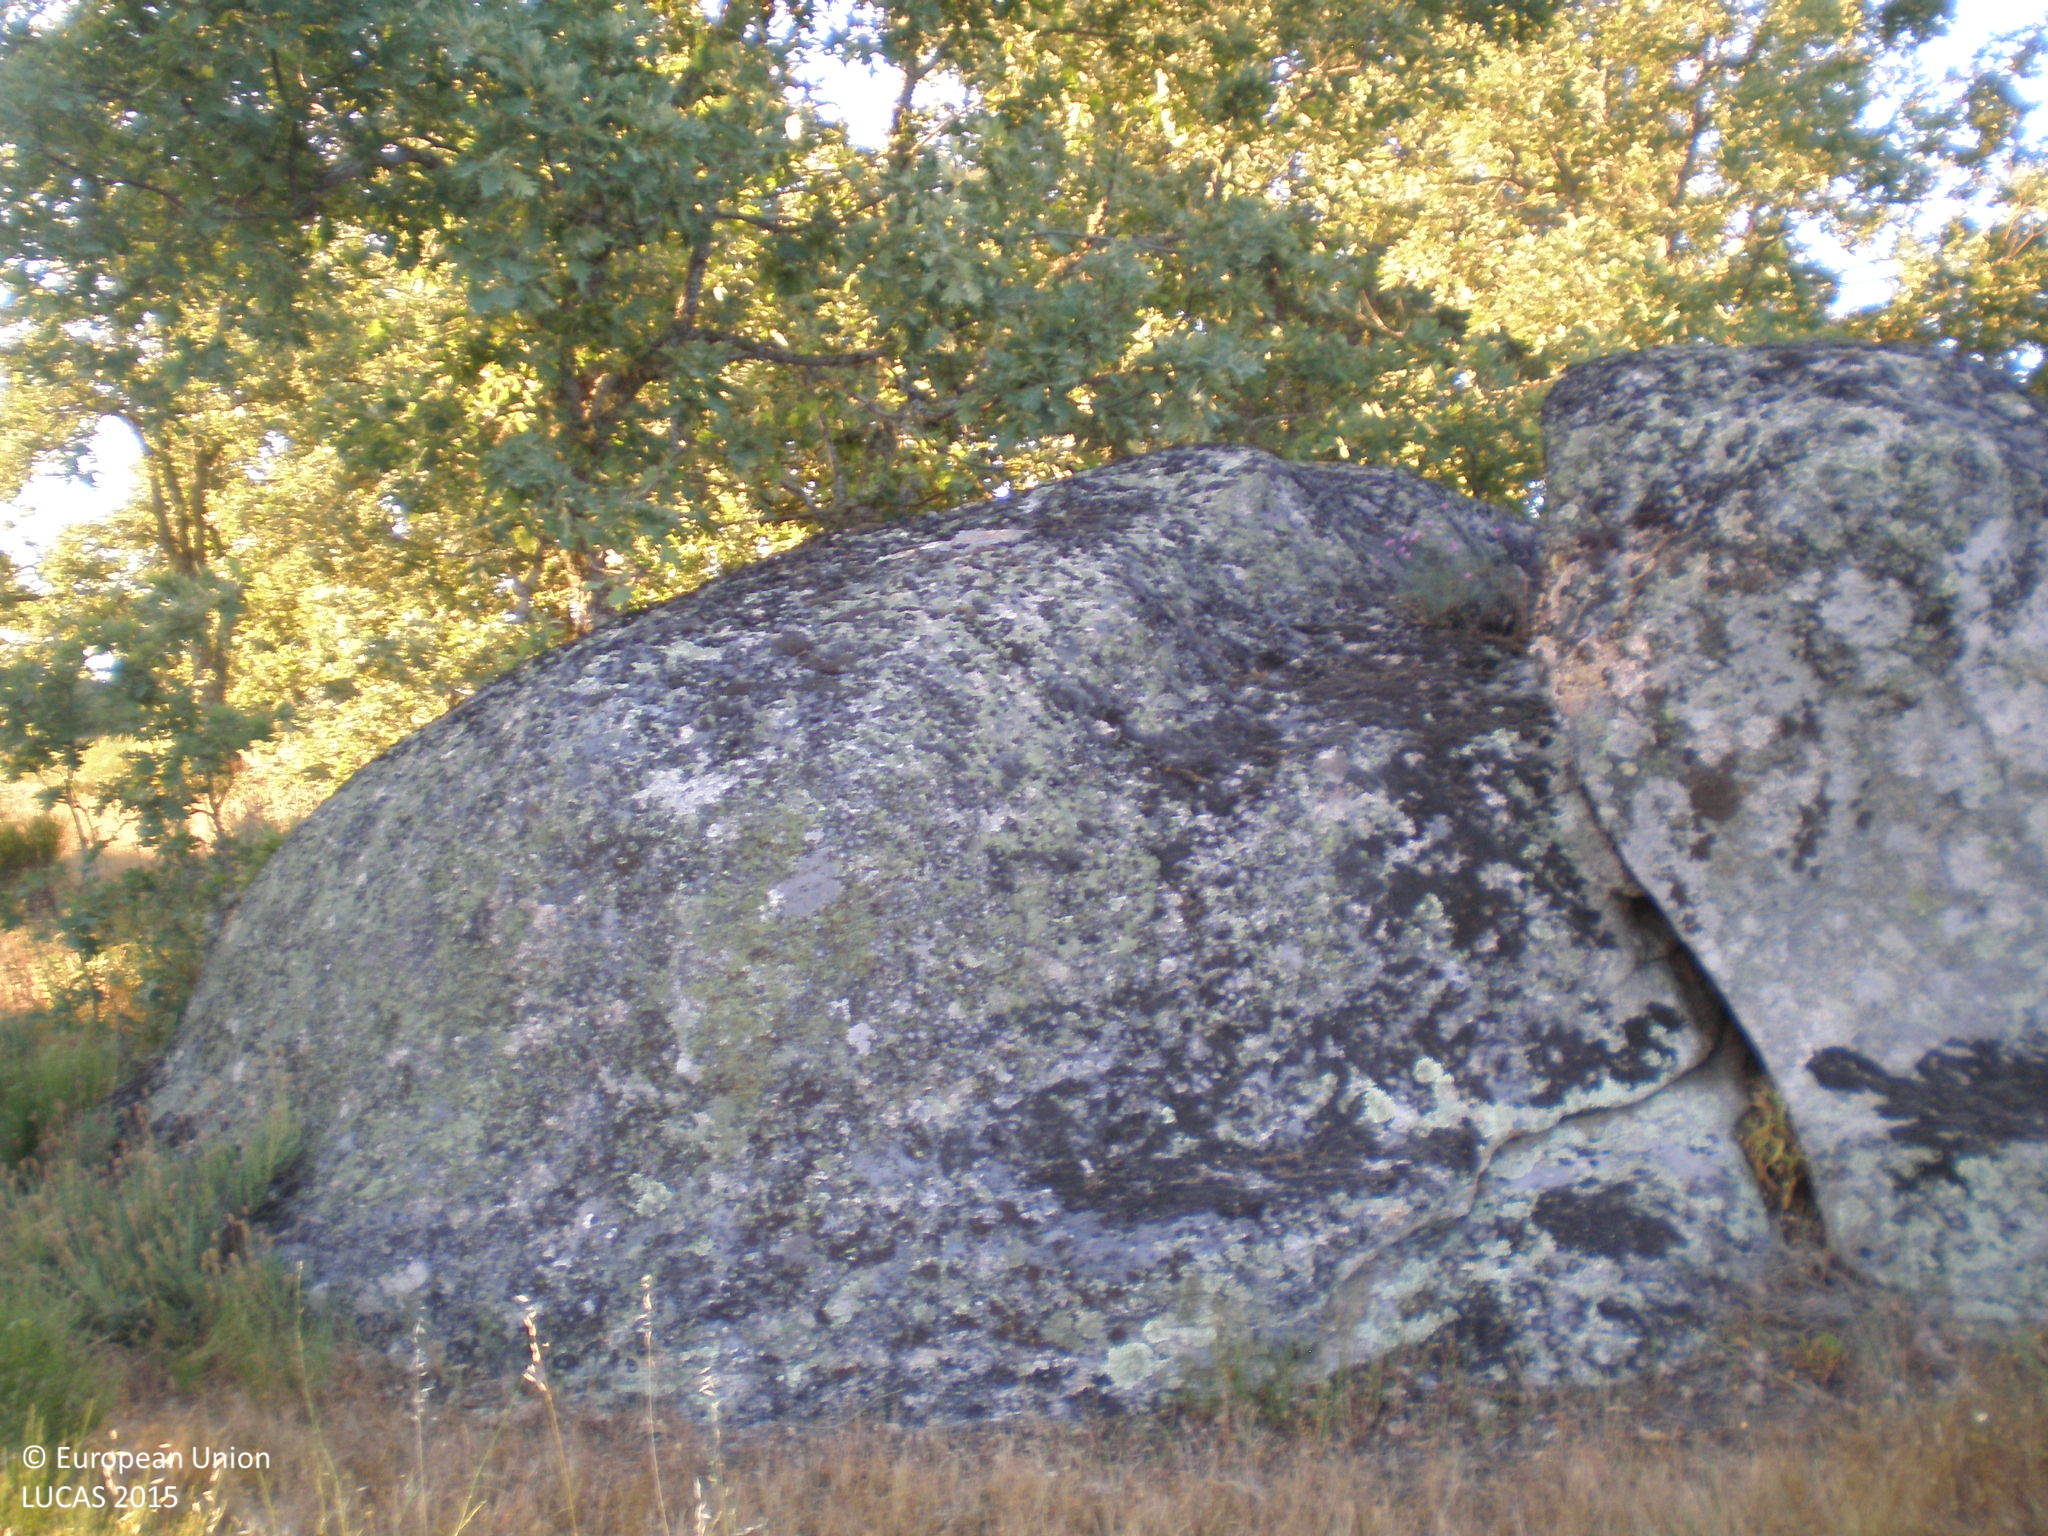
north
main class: Grassland
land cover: Grassland with sparse tree/shrub cover
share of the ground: > 75 %
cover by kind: herbaceous plants 95 %, broadleaved forest trees 5 %
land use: Agriculture (excluding fallow land and kitchen gardens)
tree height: < 5 m
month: June
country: ES
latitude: 40.5391
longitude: -5.8121
